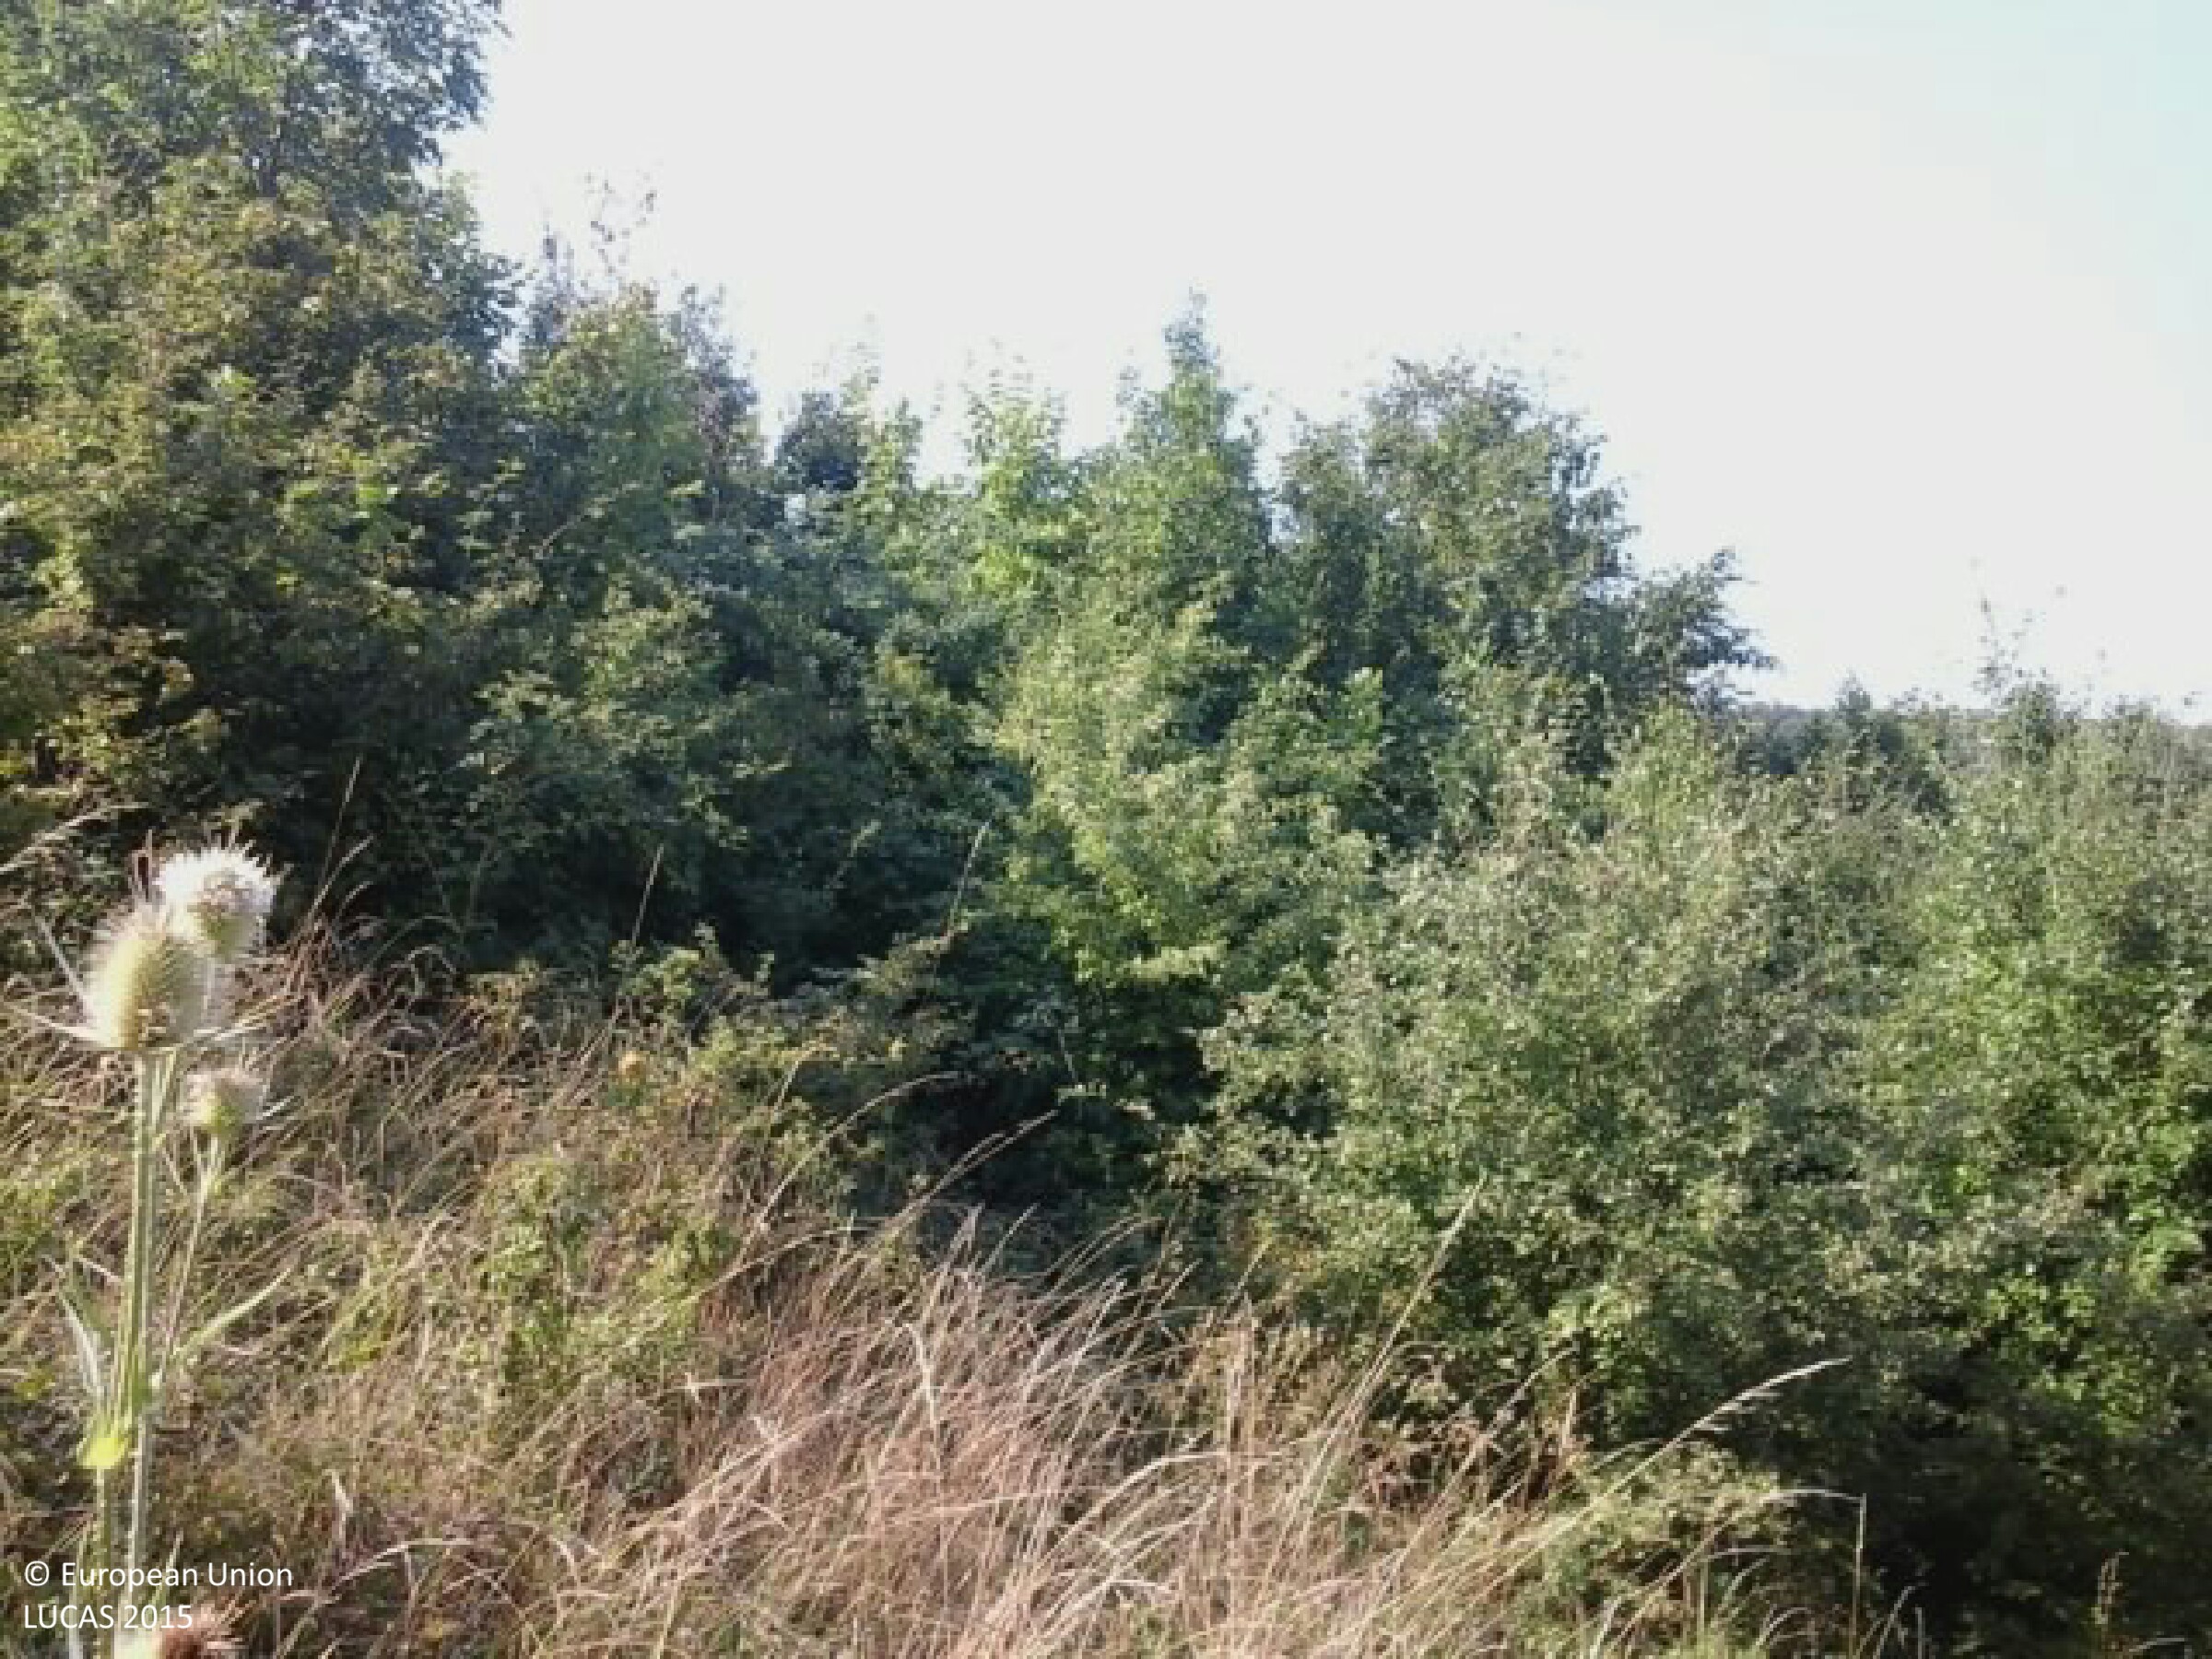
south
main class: Woodland
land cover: Broadleaved woodland
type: mesophytic deciduous forest
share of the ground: > 75 %
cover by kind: broadleaved forest trees 90 %, shrubs 5 %, herbaceous plants 5 %
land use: Forestry
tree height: > 5 m
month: August
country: HU
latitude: 46.2375
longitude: 17.9296
